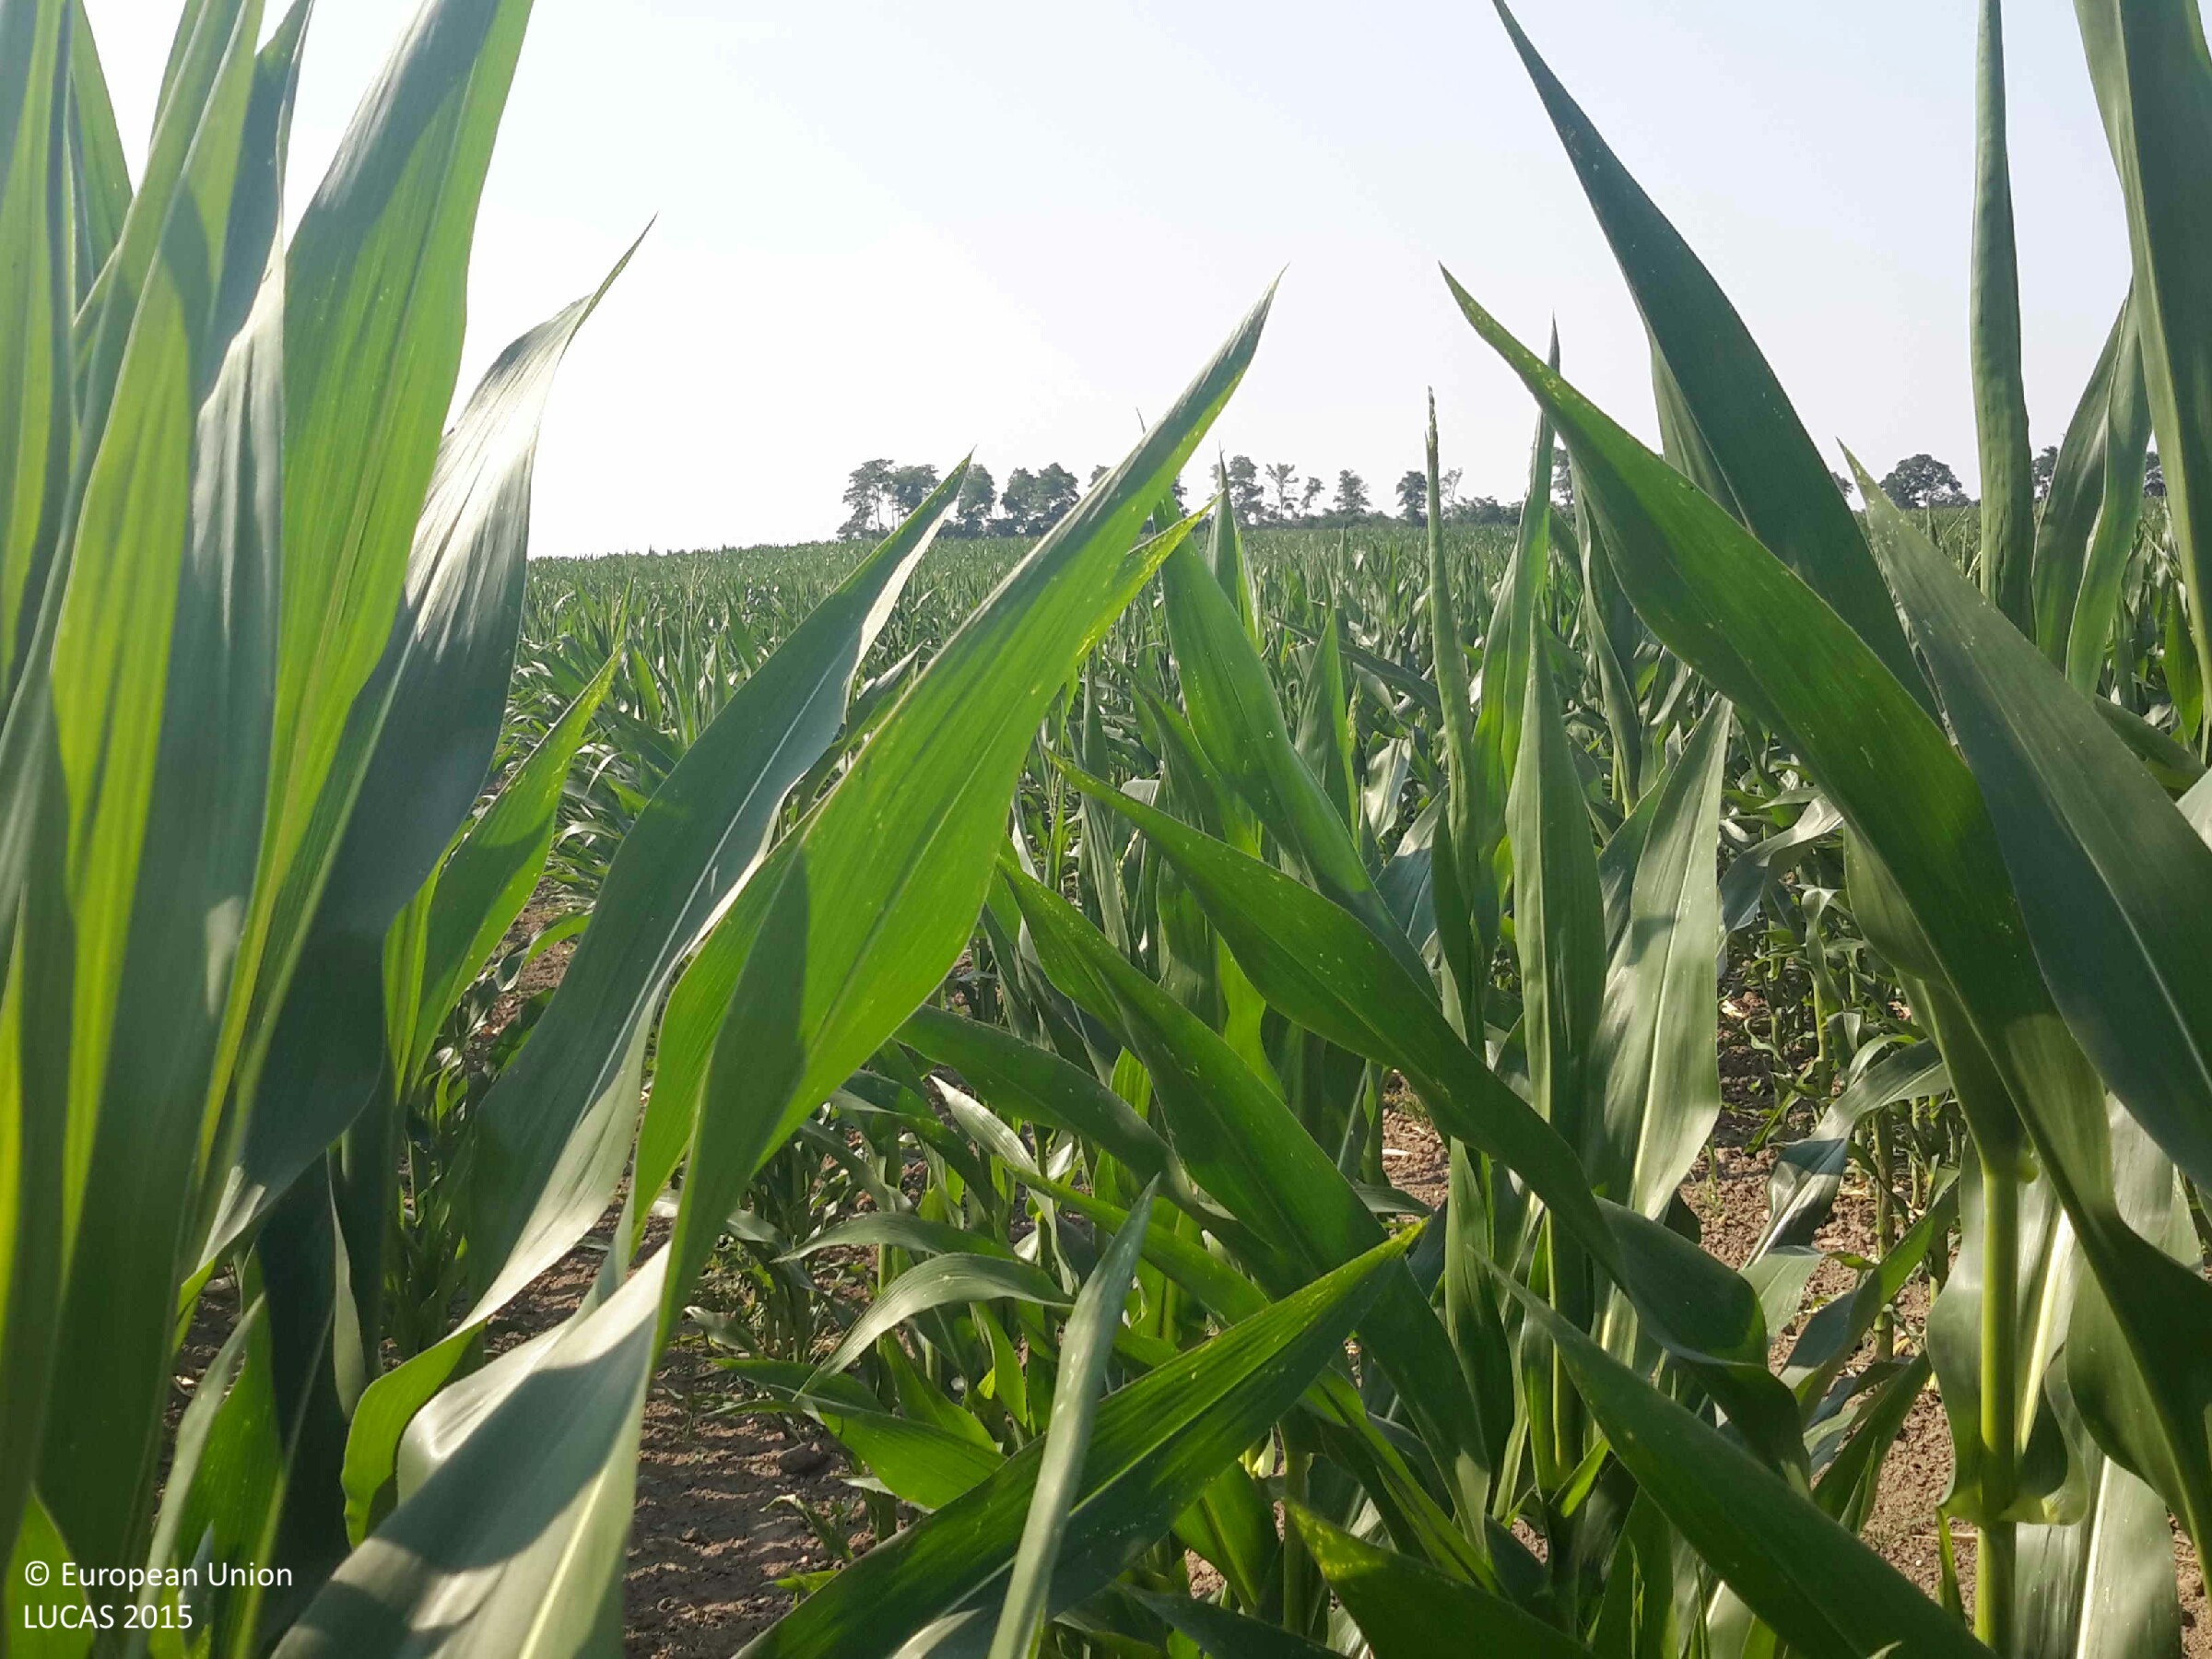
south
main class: Cropland
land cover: Maize
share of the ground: > 75 %
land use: Agriculture (excluding fallow land and kitchen gardens)
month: July
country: HU
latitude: 47.2127
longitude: 17.1752
